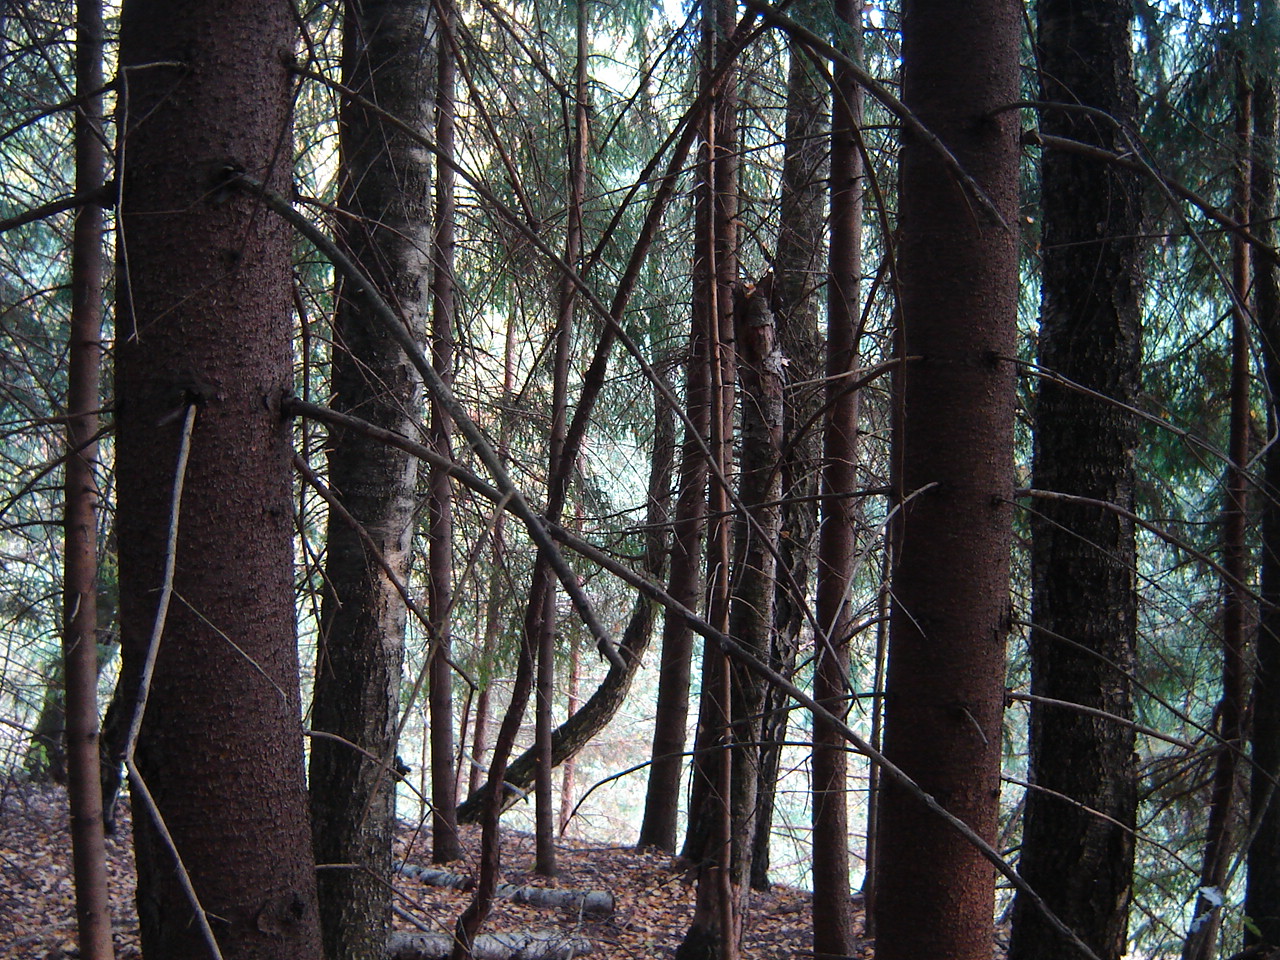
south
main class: Woodland
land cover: Pine dominated mixed woodland
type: hemiboreal forest and nemoral coniferous forest and mixed broadleaved-coniferous forest
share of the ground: > 75 %
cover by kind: coniferous forest trees 70 %, broadleaved forest trees 25 %, unconsolidated bare surface 5 %
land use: Forestry
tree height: > 5 m
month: August
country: LT
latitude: 54.7161
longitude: 24.9695
